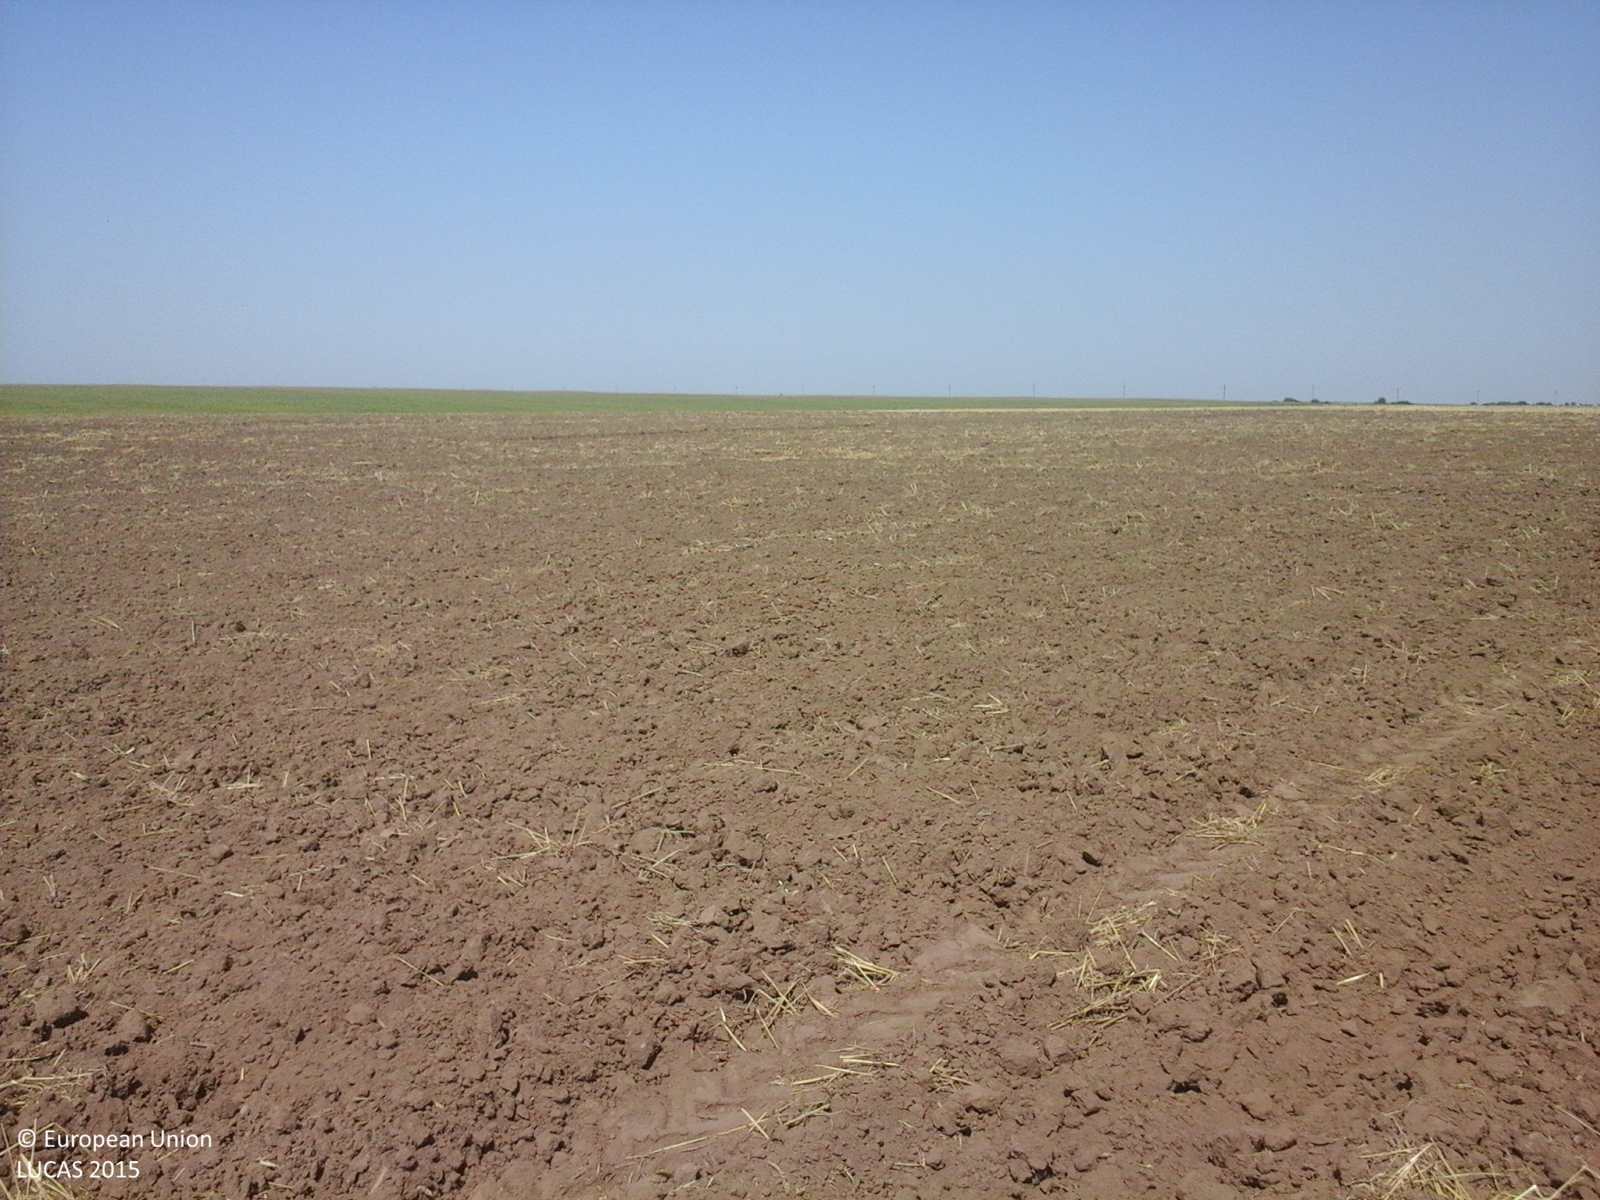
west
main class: Cropland
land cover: Common wheat
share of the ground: < 10 %
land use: Agriculture (excluding fallow land and kitchen gardens)
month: July
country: RO
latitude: 44.3710
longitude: 27.7557
